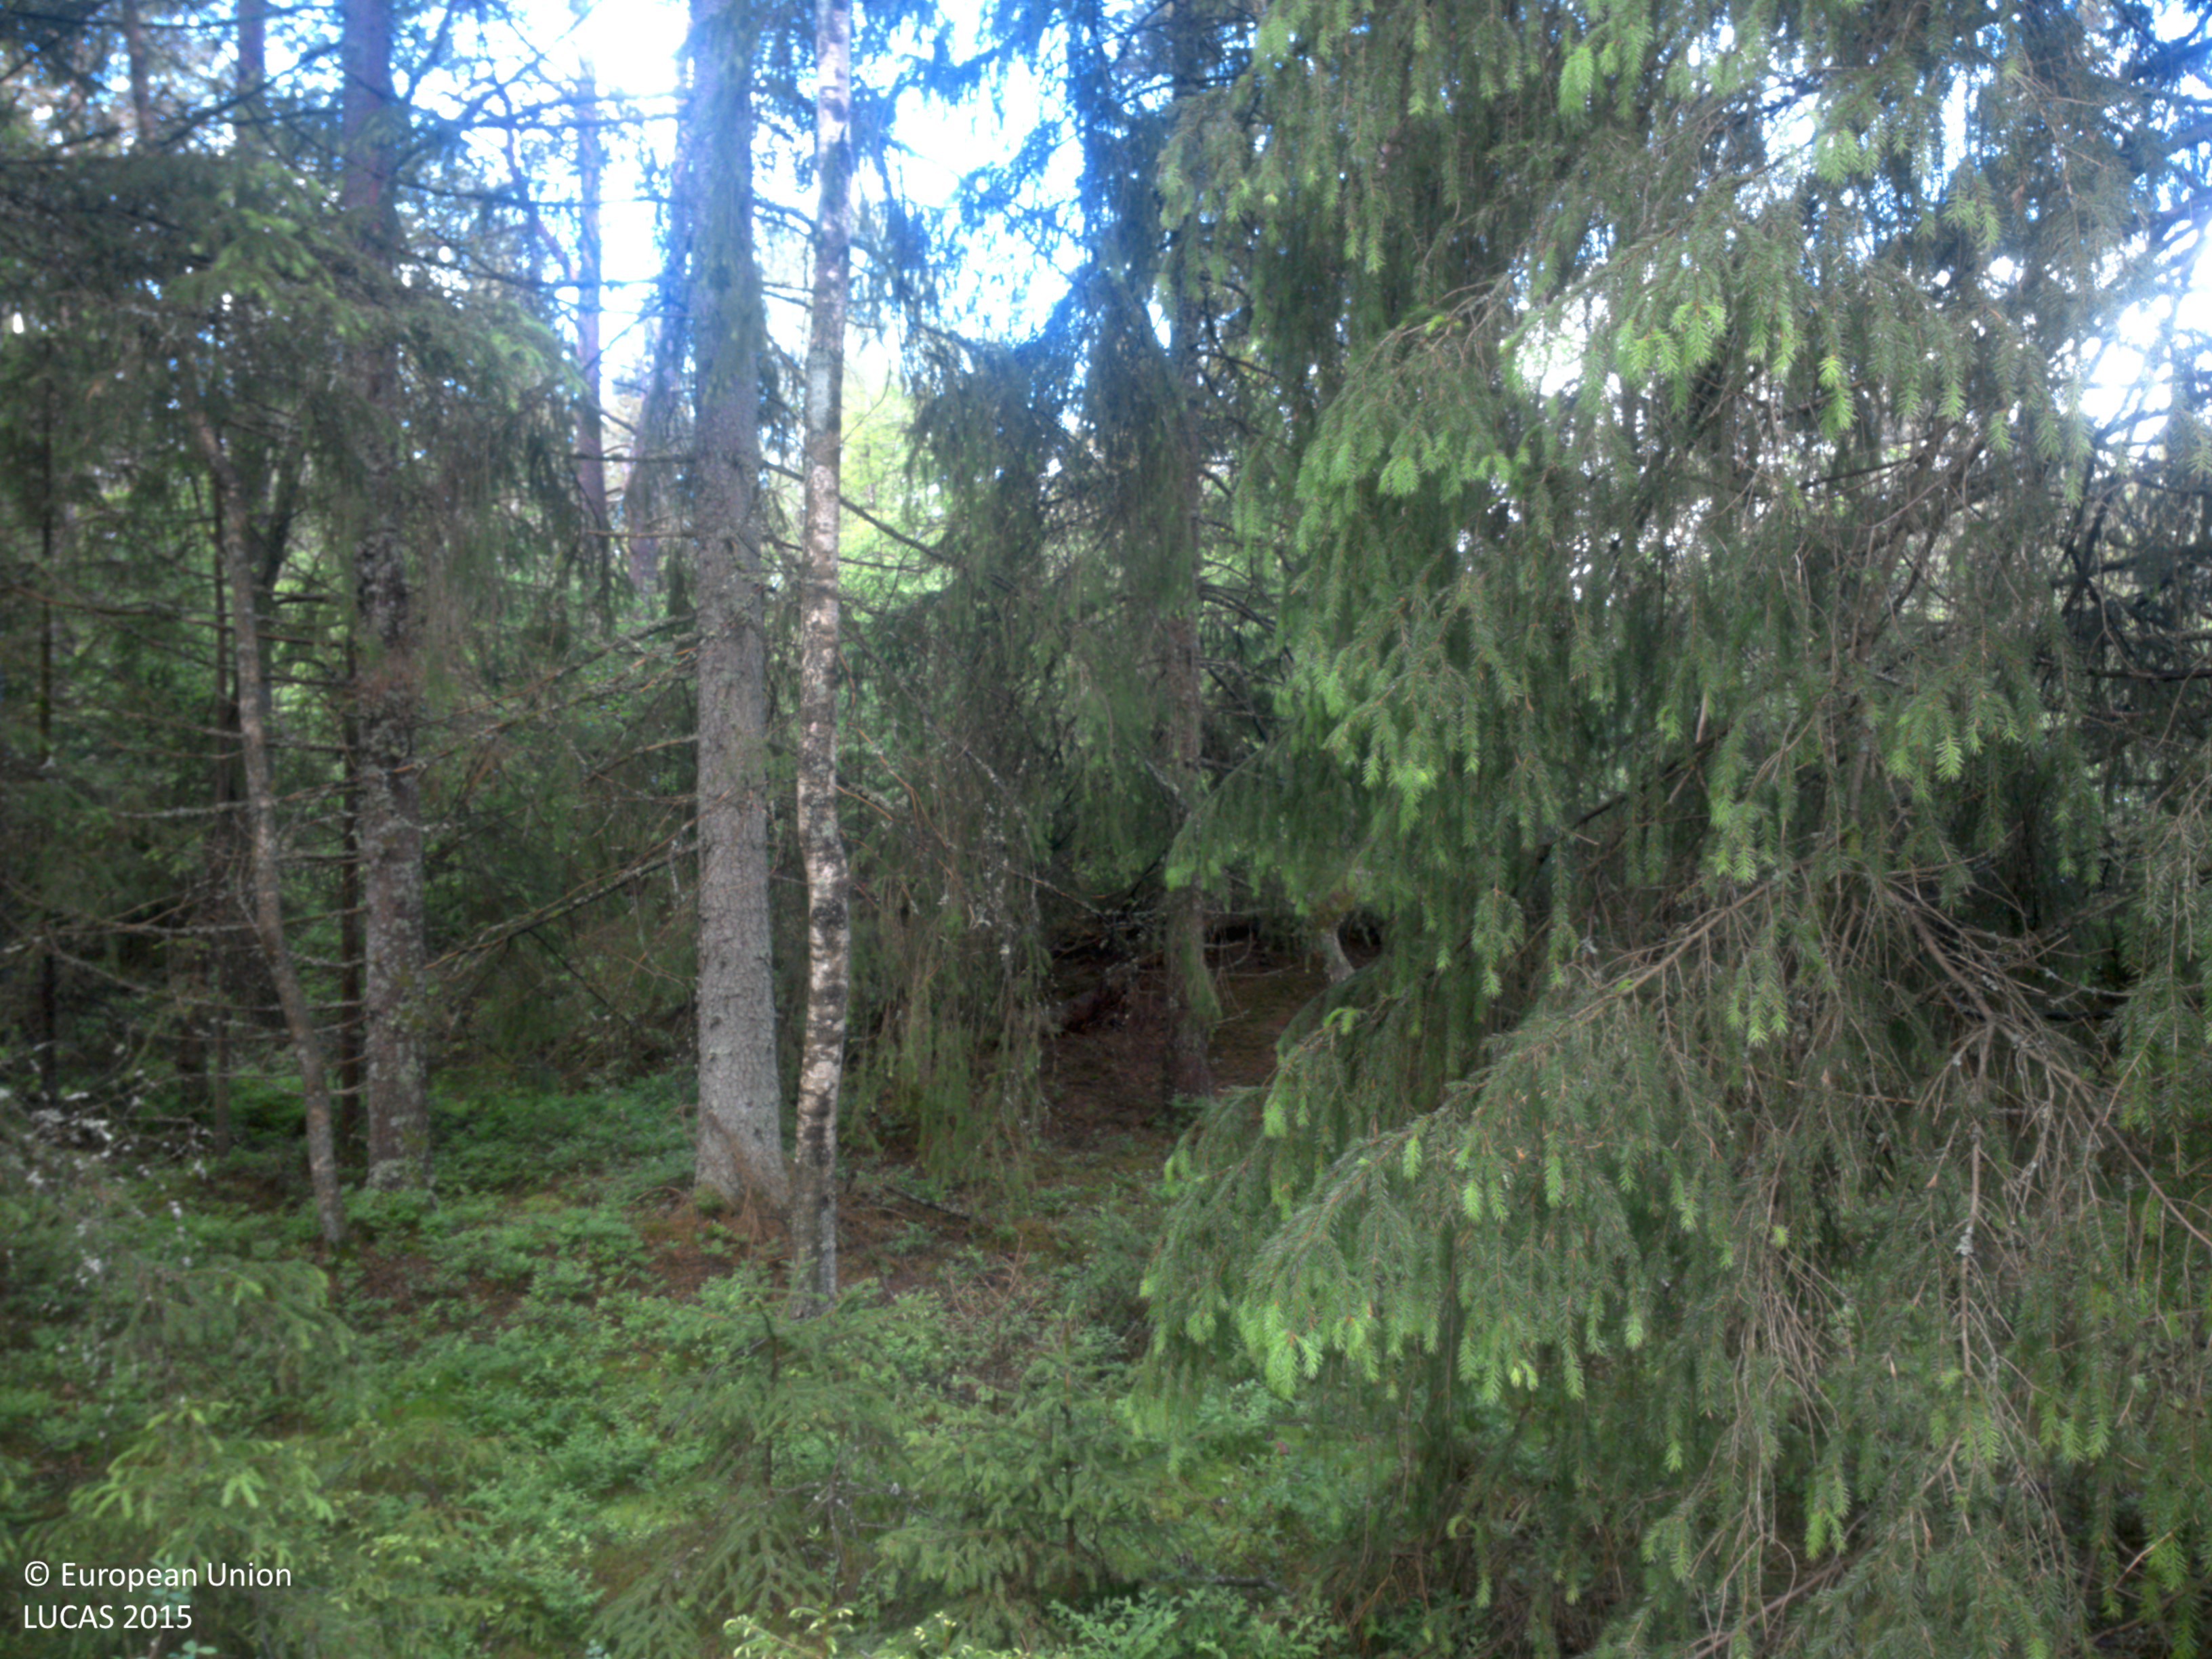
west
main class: Woodland
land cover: Spruce dominated coniferous woodland
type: boreal forest
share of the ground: 50 - 75 %
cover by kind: coniferous forest trees 50 %, lichens and mosses 30 %, shrubs 20 %
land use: Forestry
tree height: > 5 m
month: June
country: SE
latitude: 58.4054
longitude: 11.7932
